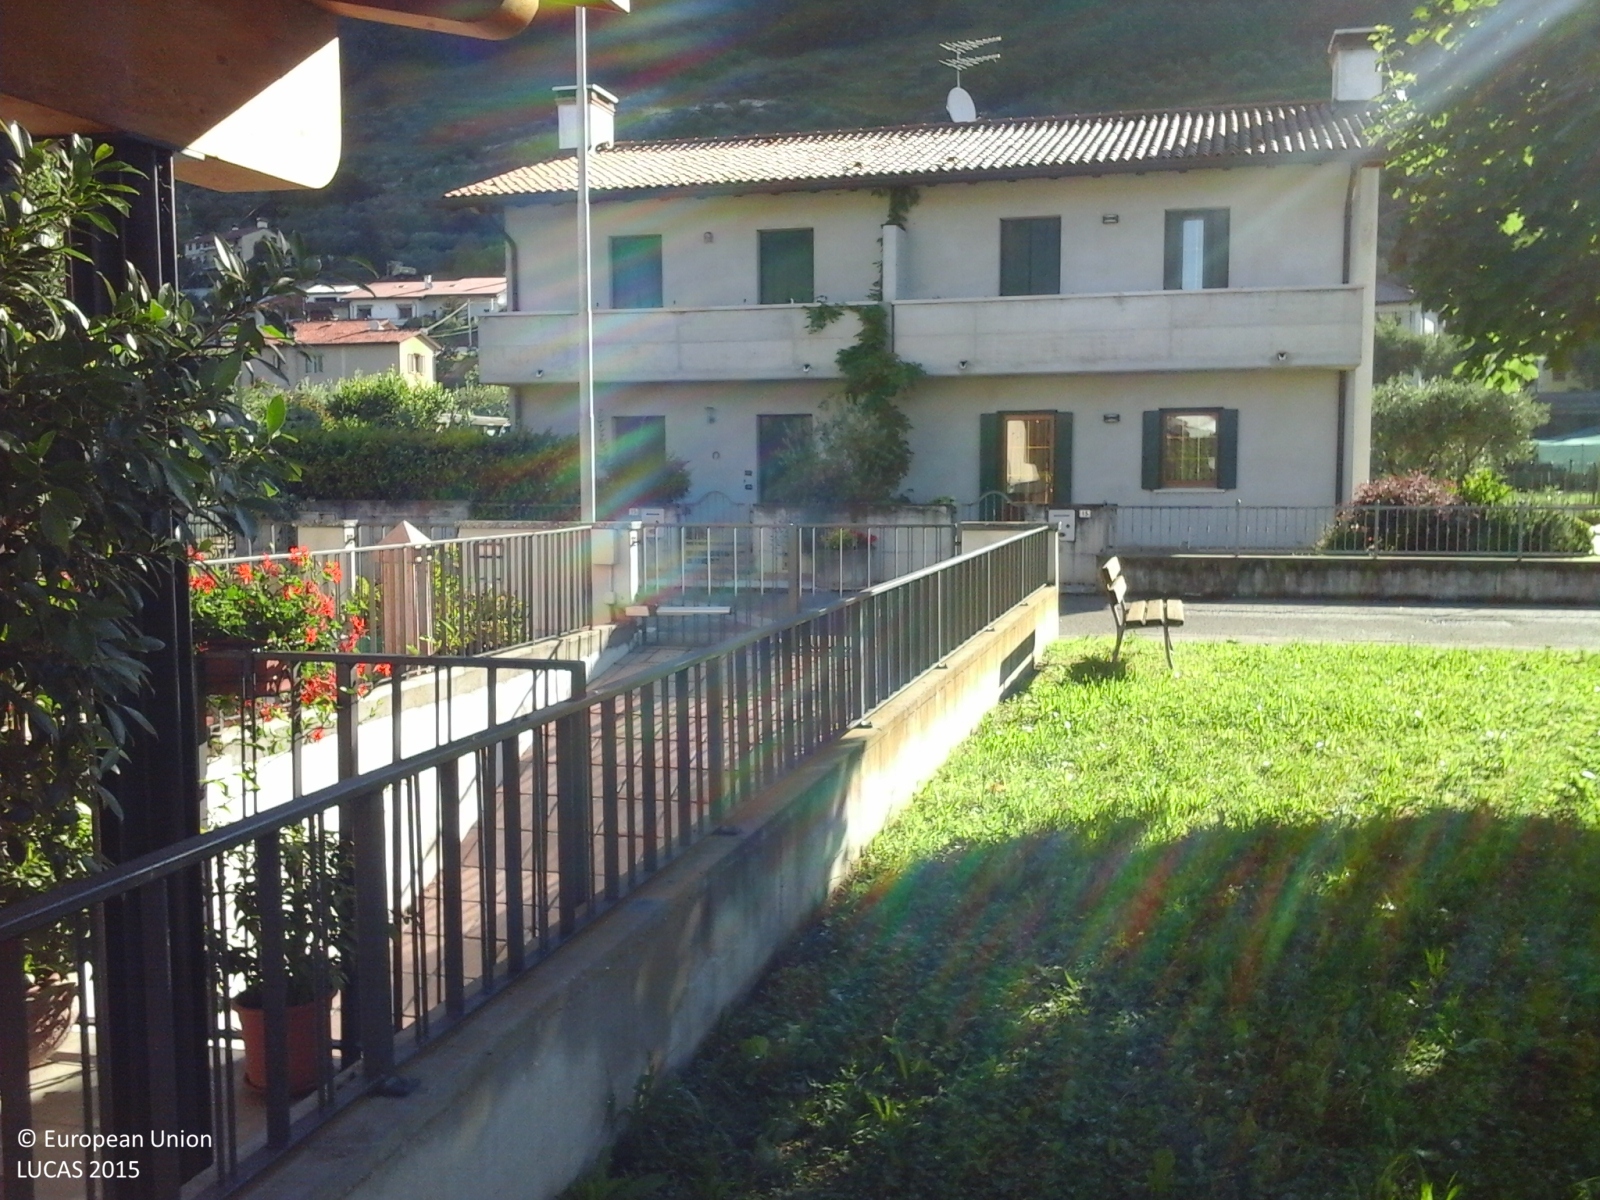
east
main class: Grassland
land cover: Grassland with sparse tree/shrub cover
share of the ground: > 75 %
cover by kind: herbaceous plants 95 %, broadleaved forest trees 5 %
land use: Amenities, museums, leisure
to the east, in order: Grassland with sparse tree/shrub cover; Artificial constructions in urban areas; Olive groves
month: June
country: IT
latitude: 45.7966
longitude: 11.7342
